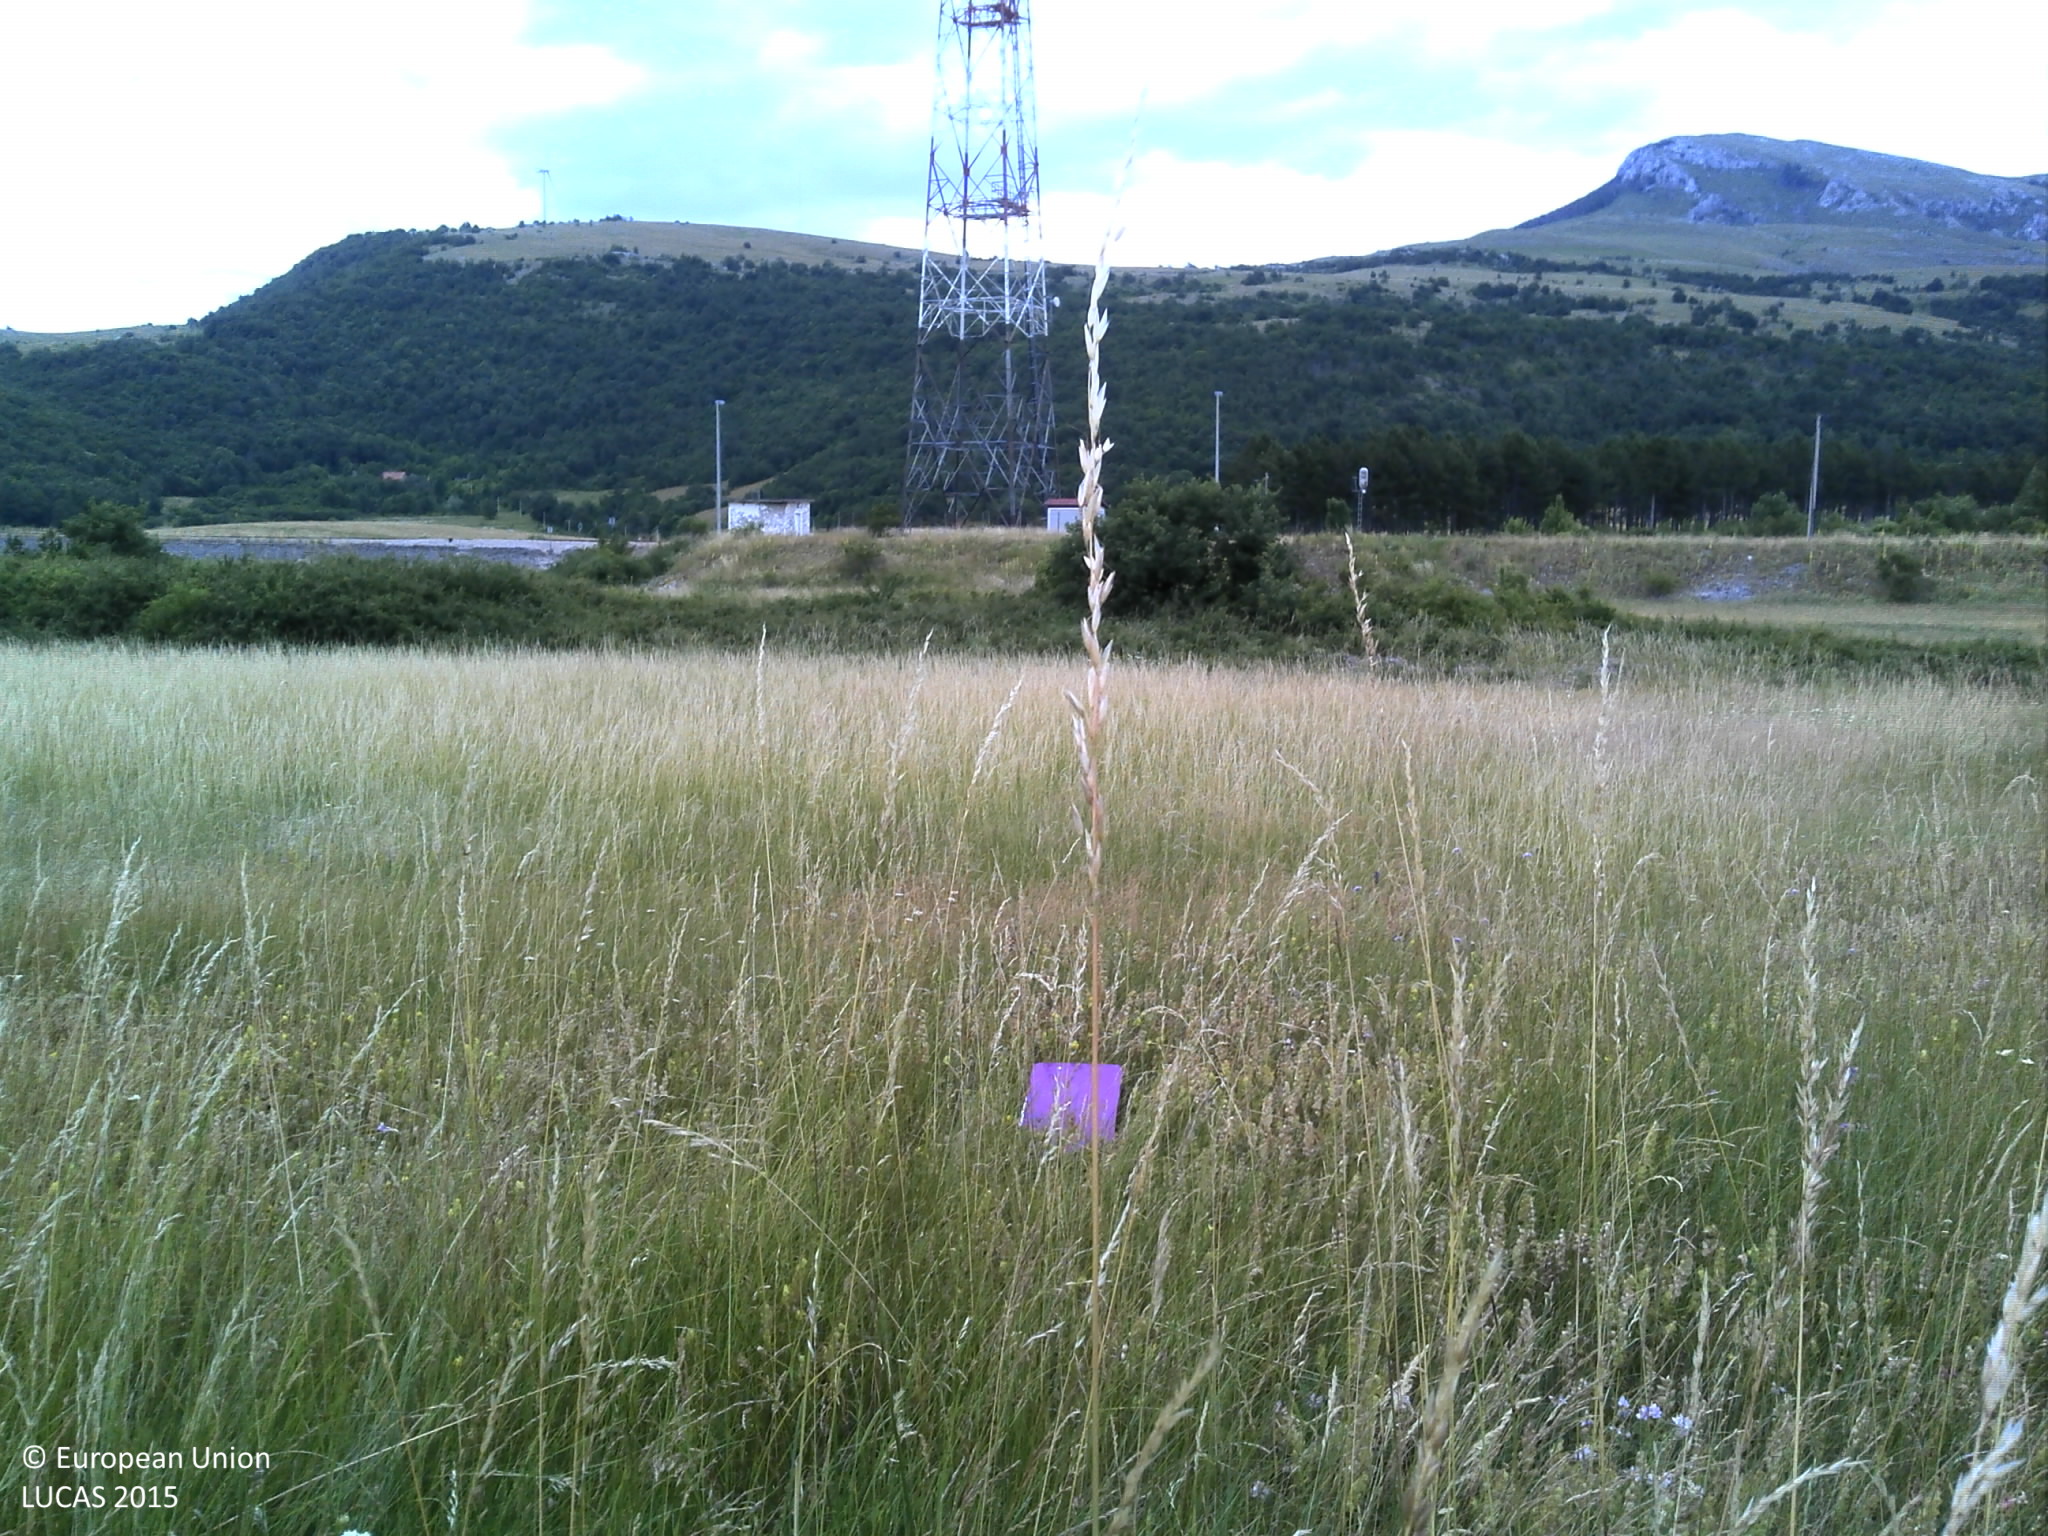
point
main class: Grassland
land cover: Grassland without tree/shrub cover
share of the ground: > 75 %
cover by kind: herbaceous plants 100 %
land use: Semi-natural and natural areas not in use
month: June
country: HR
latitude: 44.2454
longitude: 16.0665
